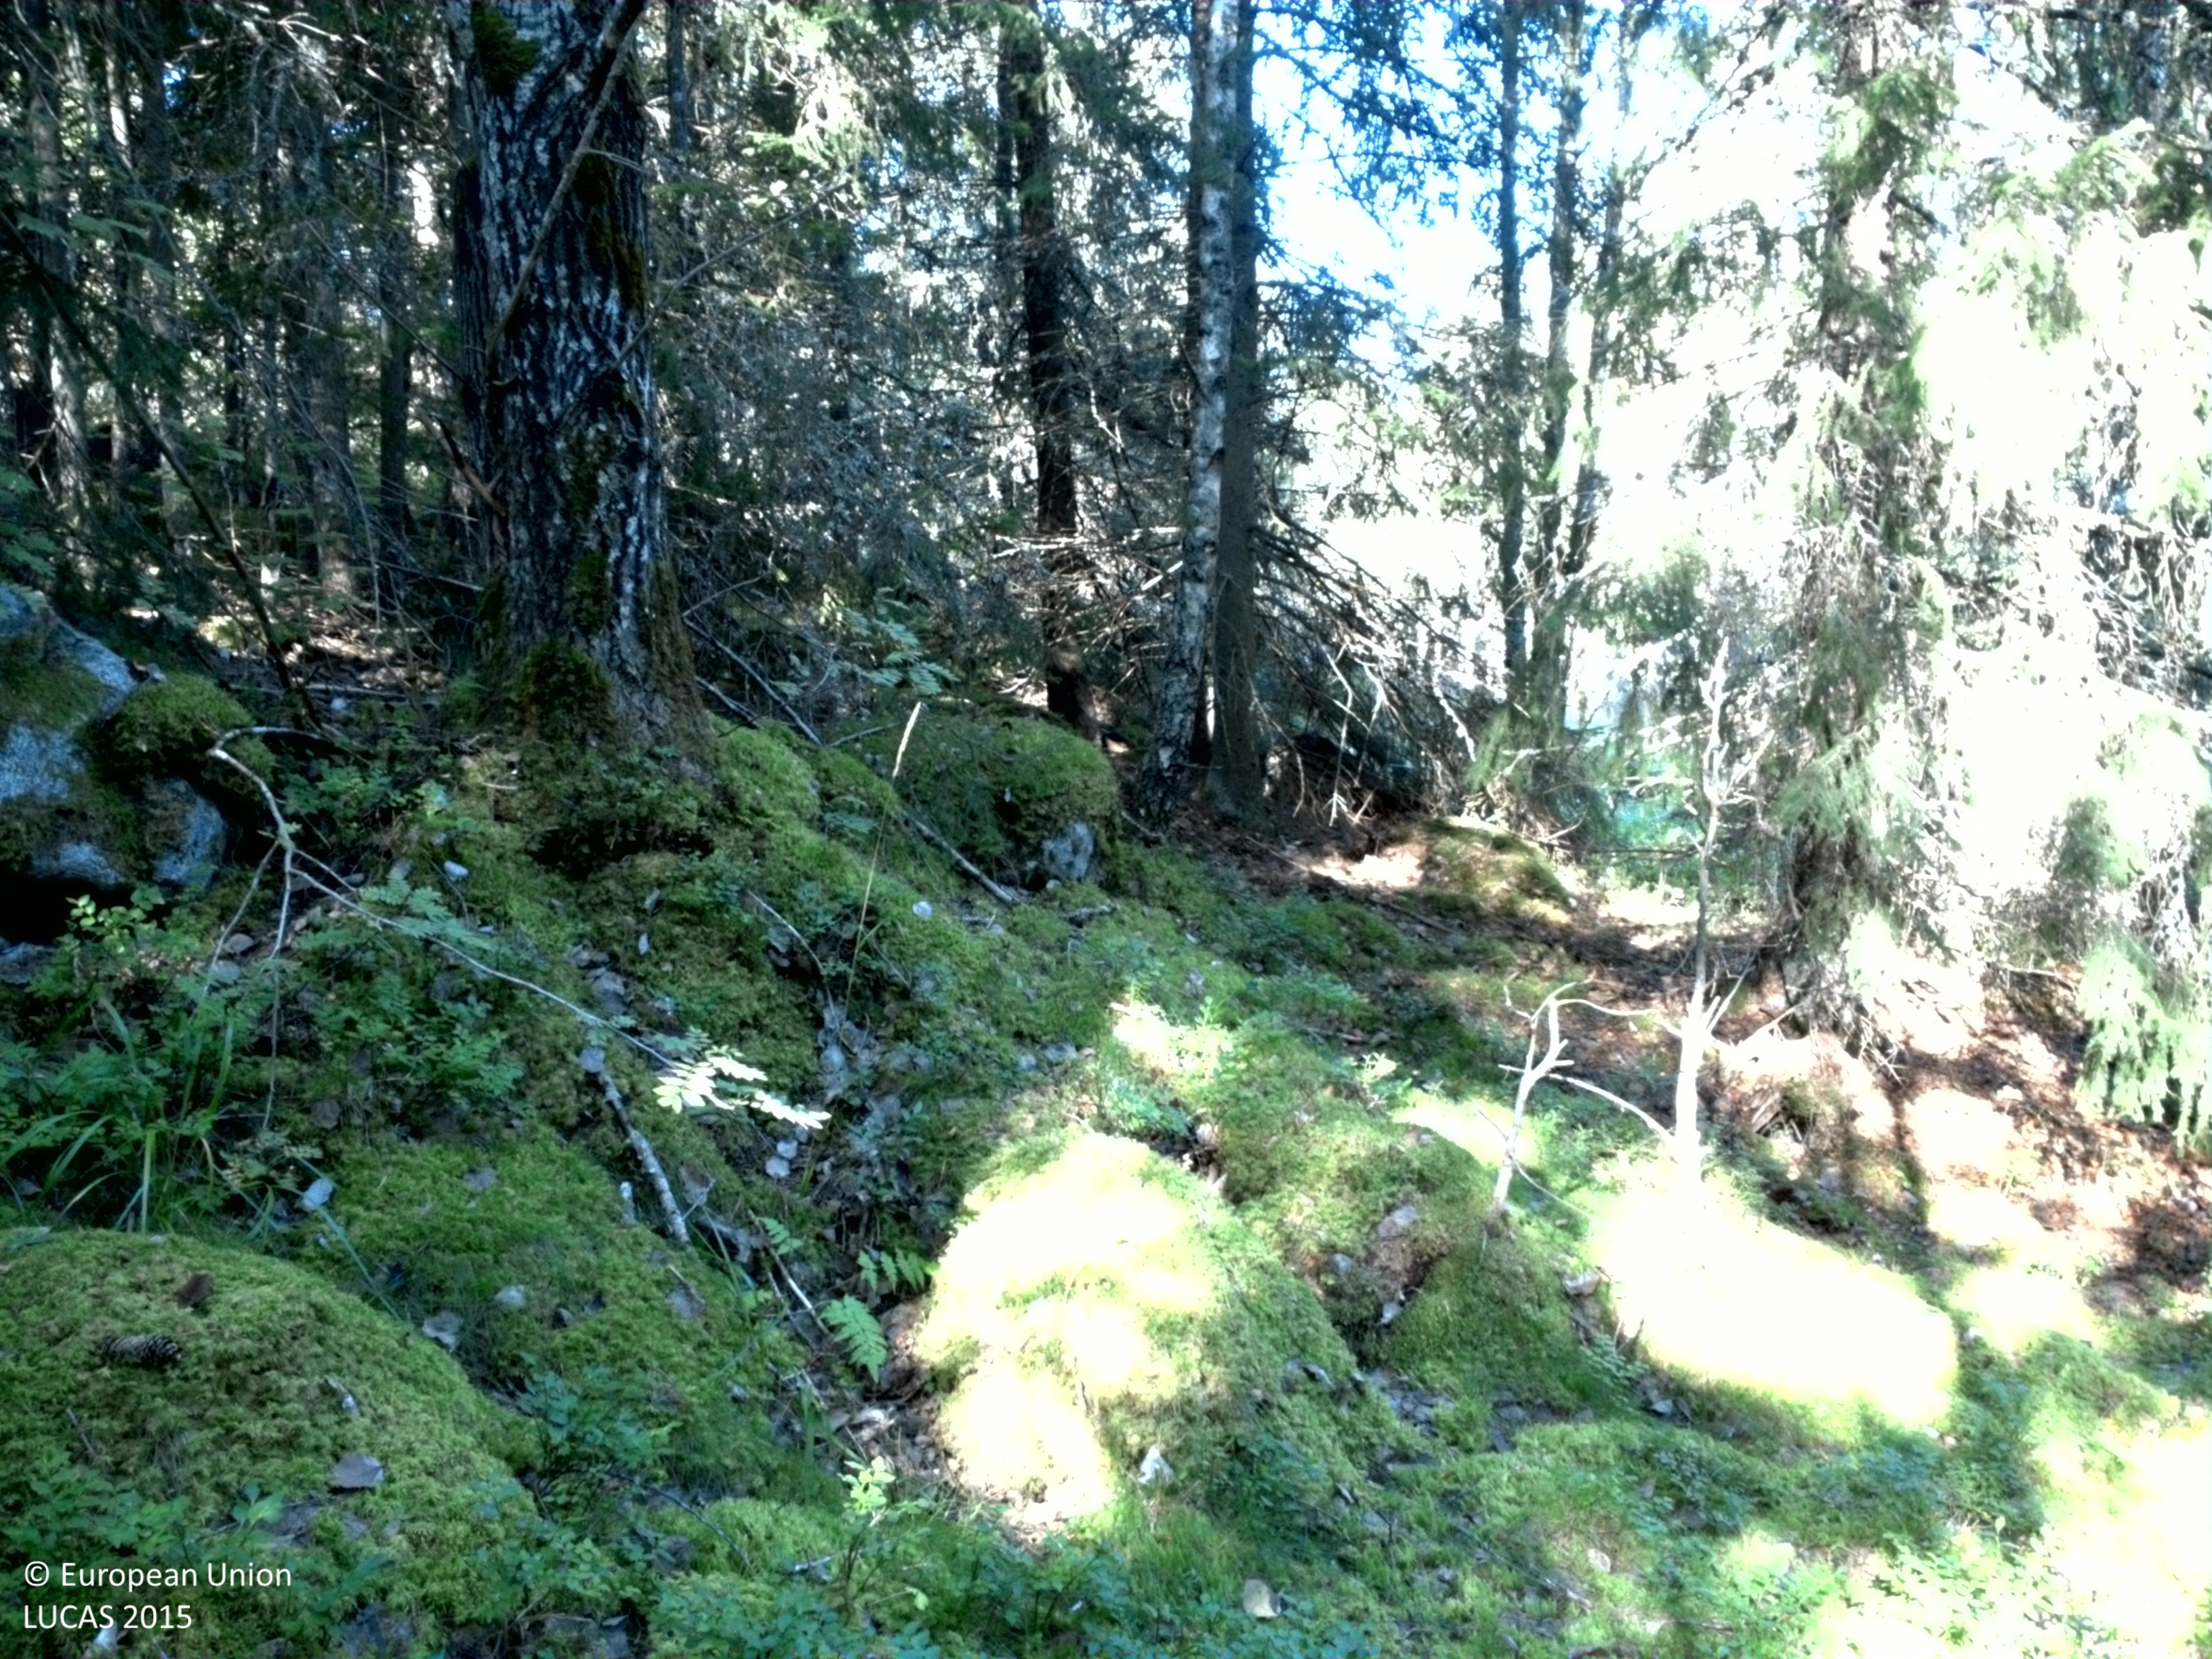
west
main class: Woodland
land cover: Spruce dominated mixed woodland
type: boreal forest
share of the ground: 50 - 75 %
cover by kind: coniferous forest trees 50 %, lichens and mosses 30 %, broadleaved forest trees 20 %
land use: Forestry
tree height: > 5 m
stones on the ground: 10 - 25 %
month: August
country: SE
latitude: 59.7812
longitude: 17.1716
